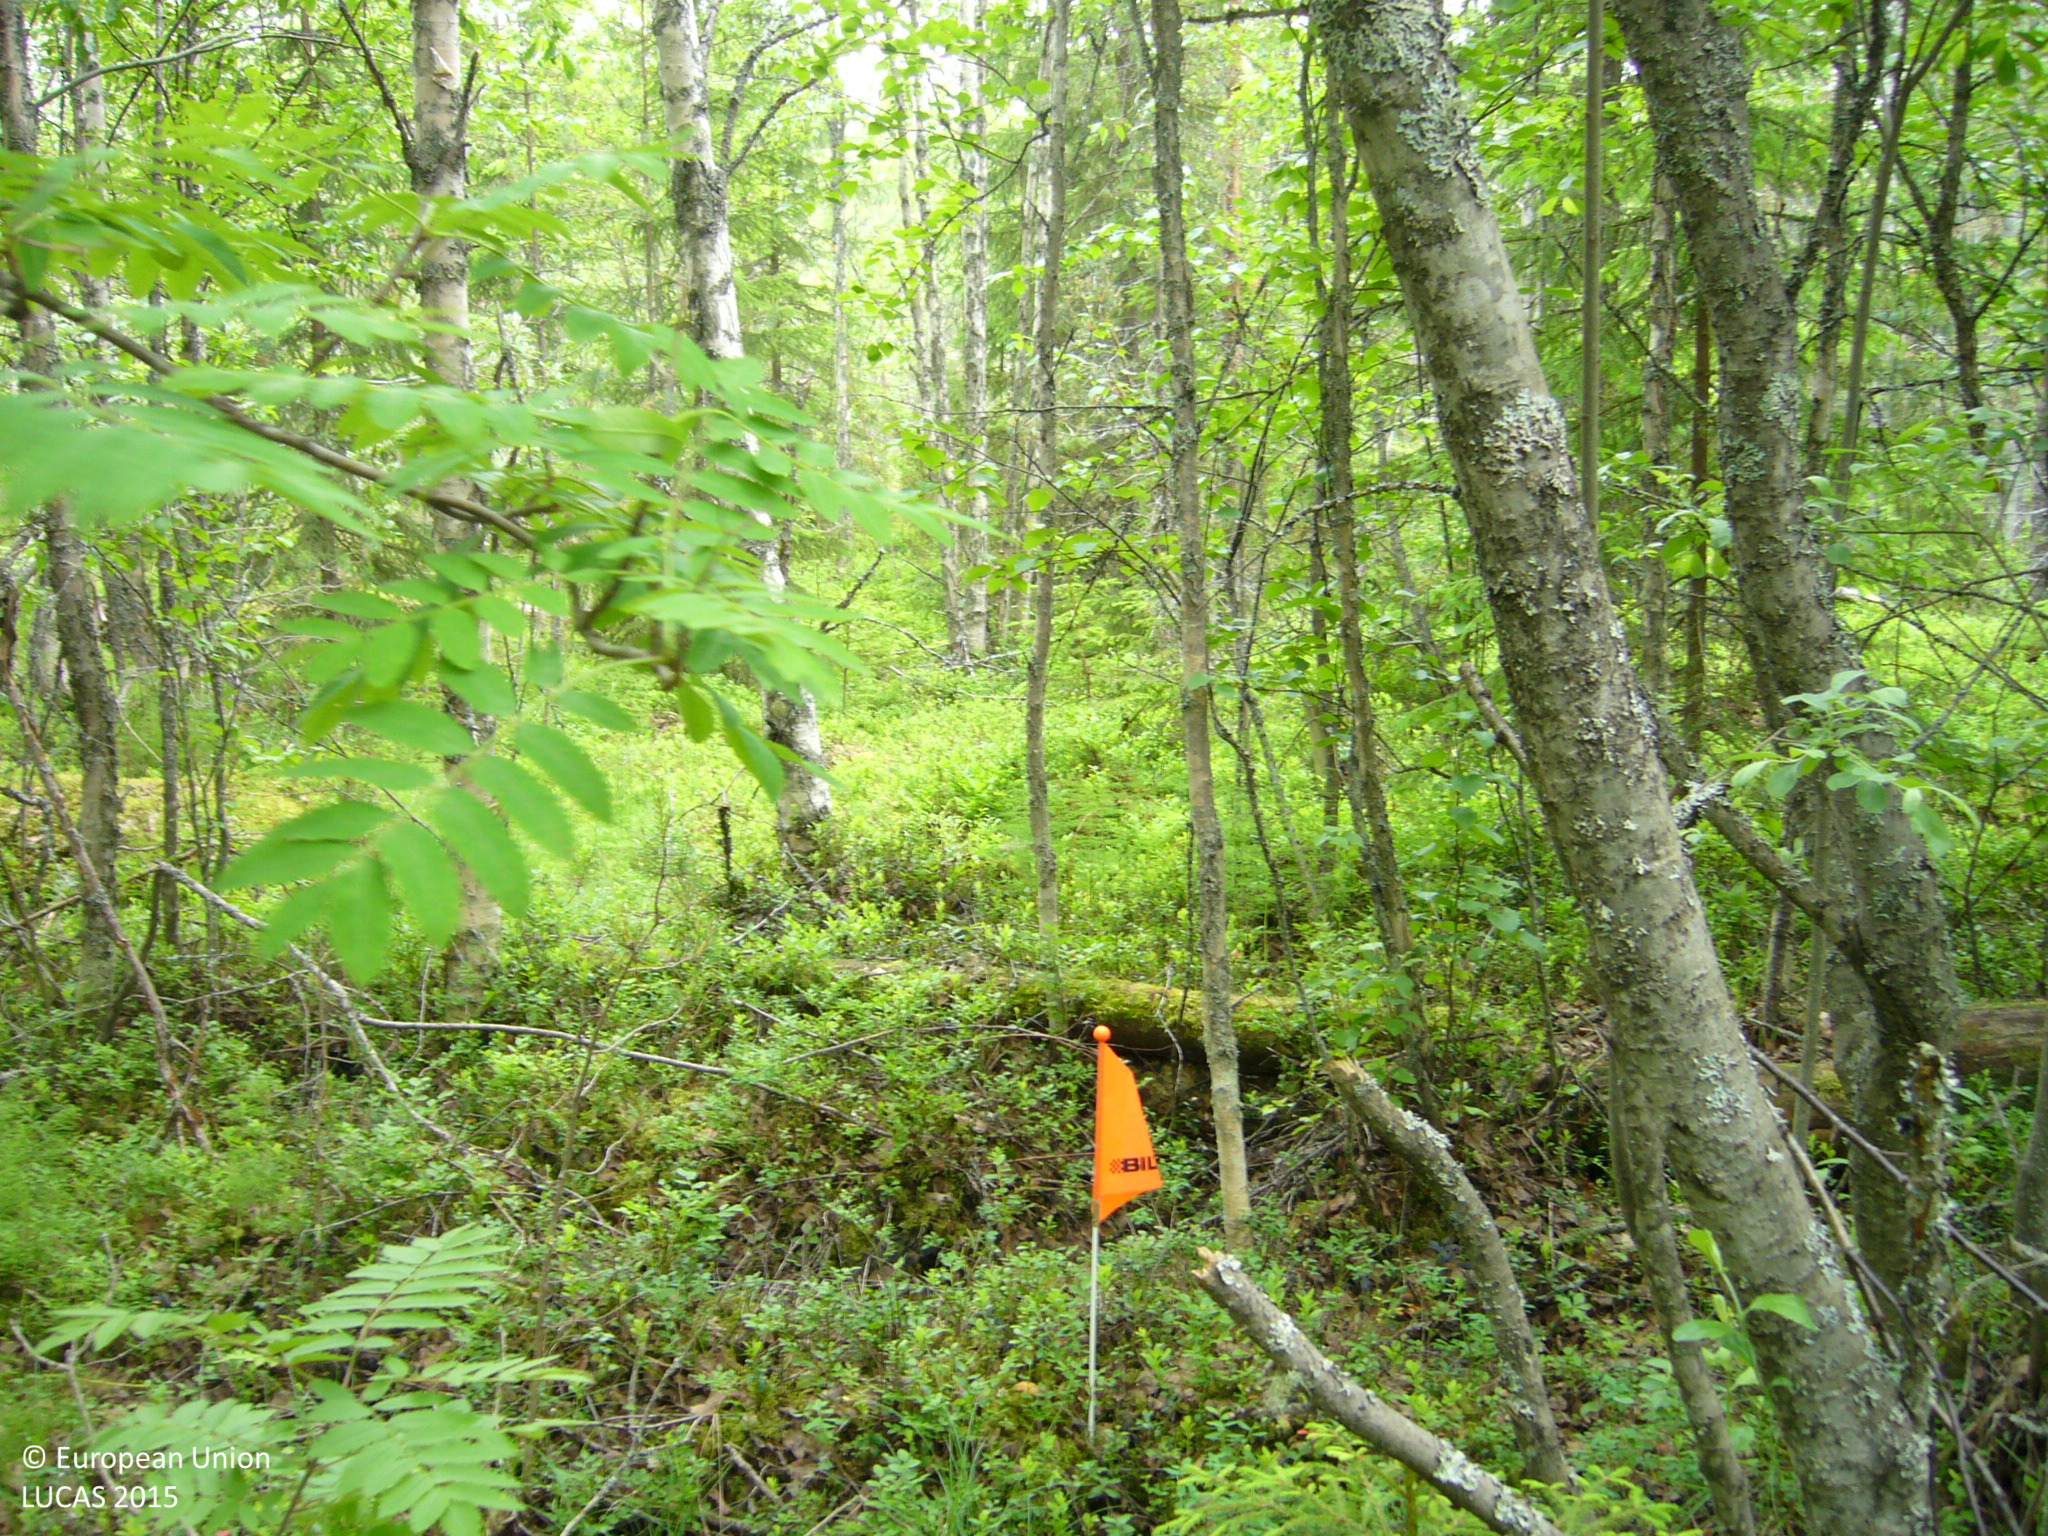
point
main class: Woodland
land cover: Other mixed woodland
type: boreal forest
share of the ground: > 75 %
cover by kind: broadleaved forest trees 55 %, coniferous forest trees 30 %, shrubs 15 %
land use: Forestry
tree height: > 5 m
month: July
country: FI
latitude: 63.4482
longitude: 26.1800
